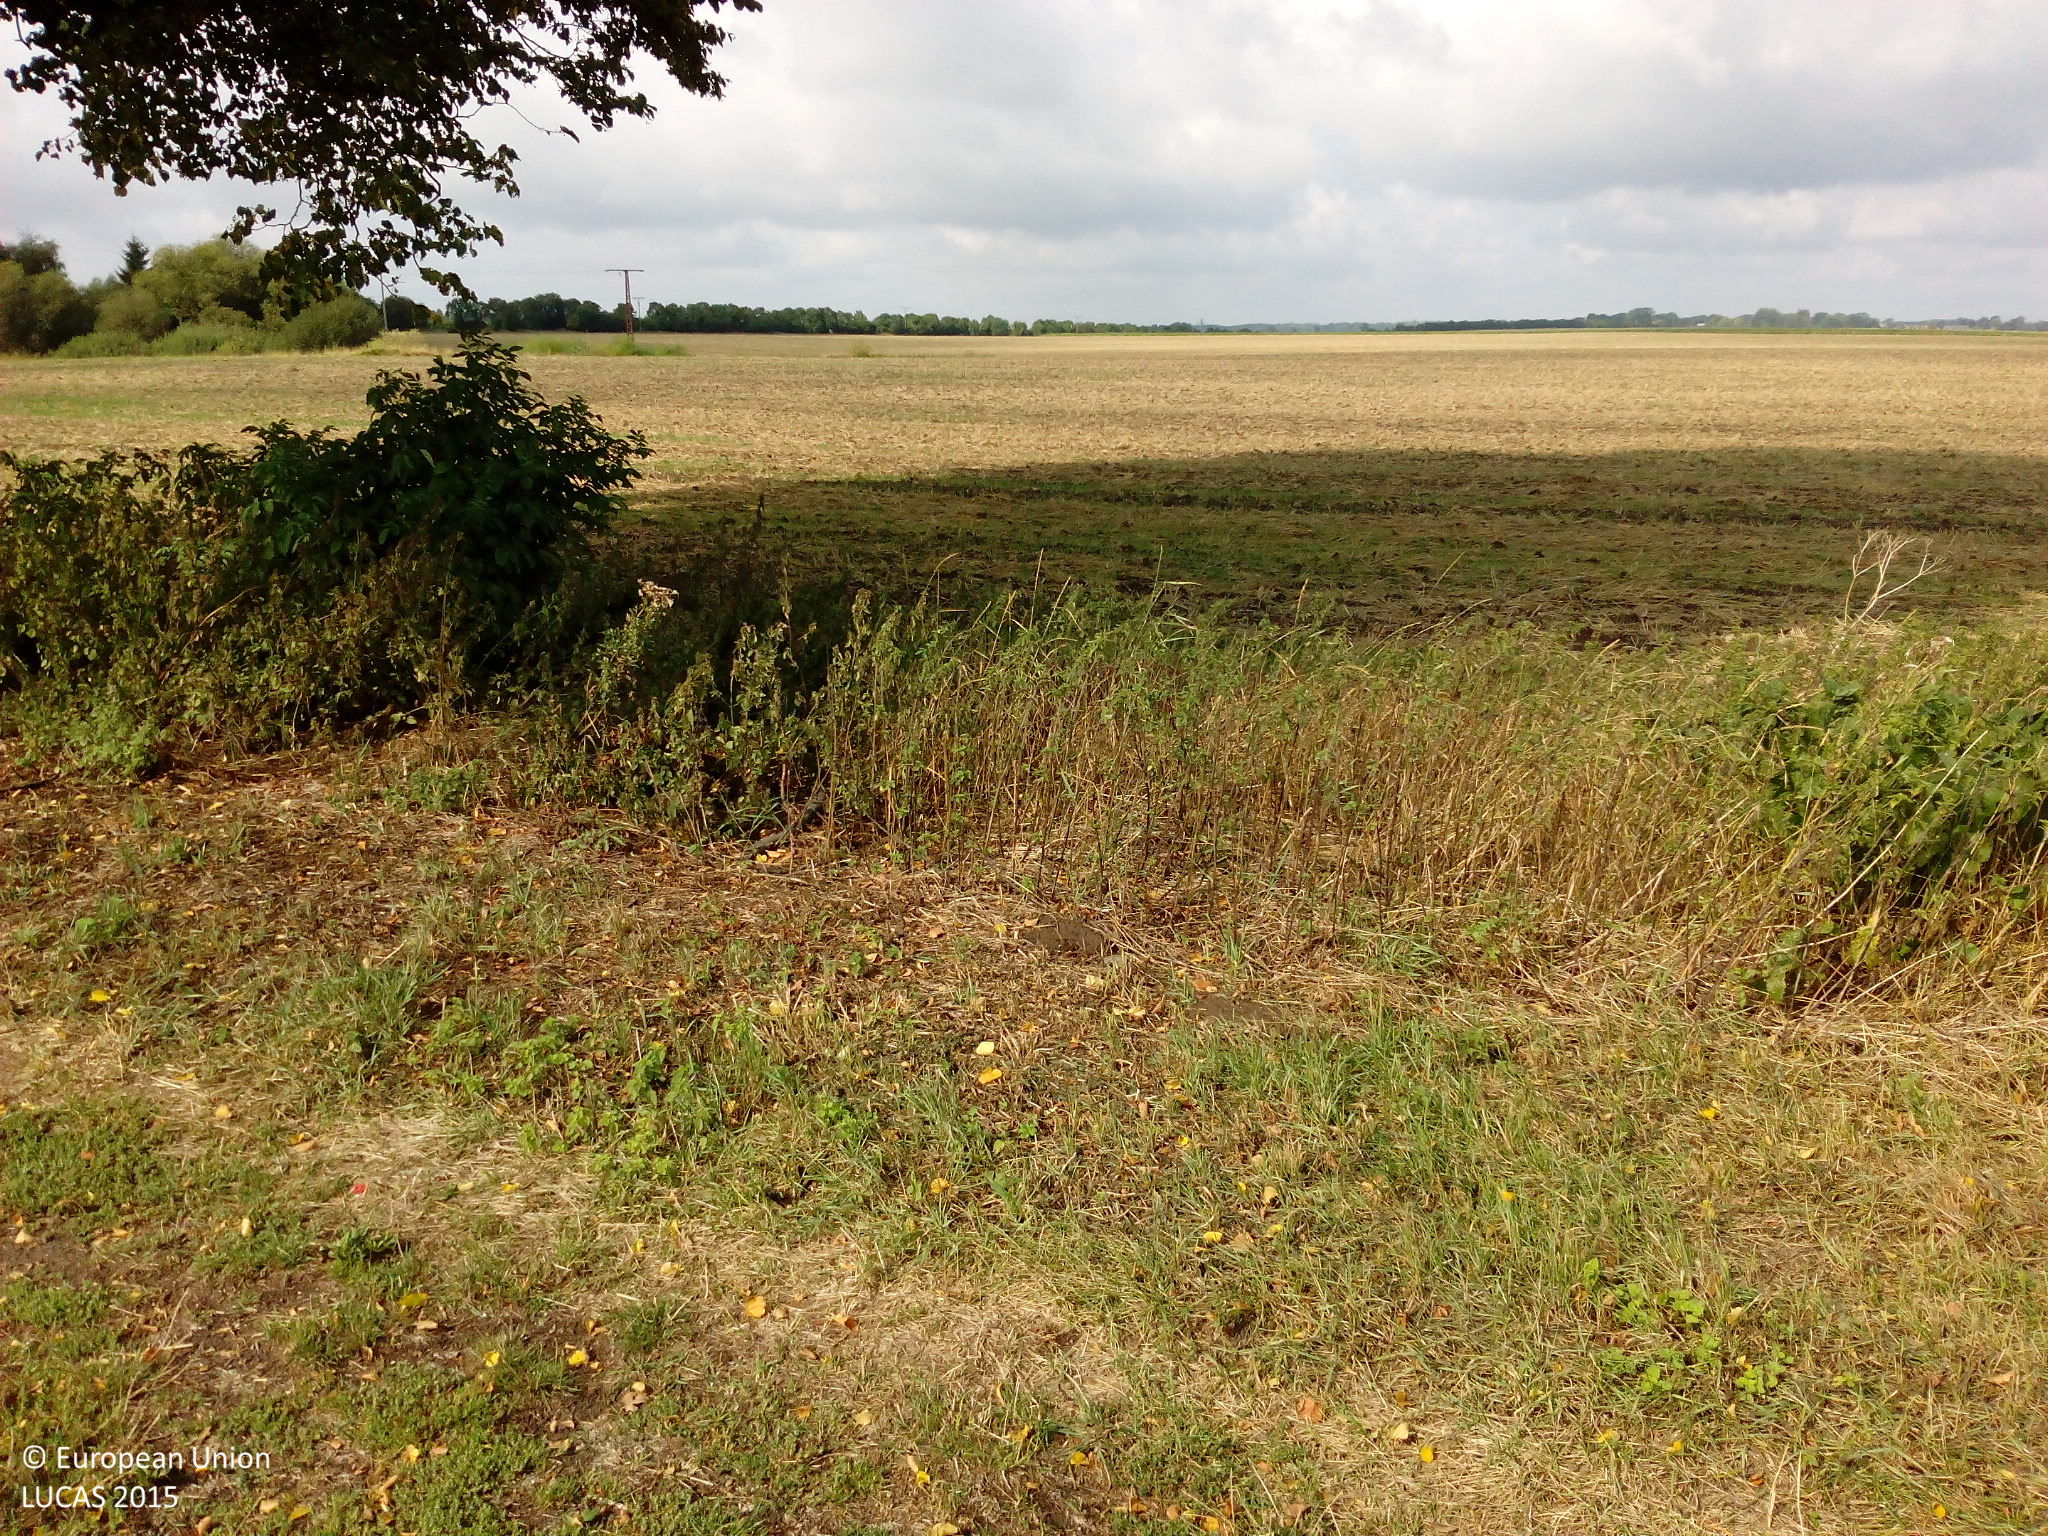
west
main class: Cropland
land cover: Rape and turnip rape
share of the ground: < 10 %
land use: Agriculture (excluding fallow land and kitchen gardens)
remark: Tilled/Sowed
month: August
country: DE
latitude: 54.0192
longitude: 12.7006
